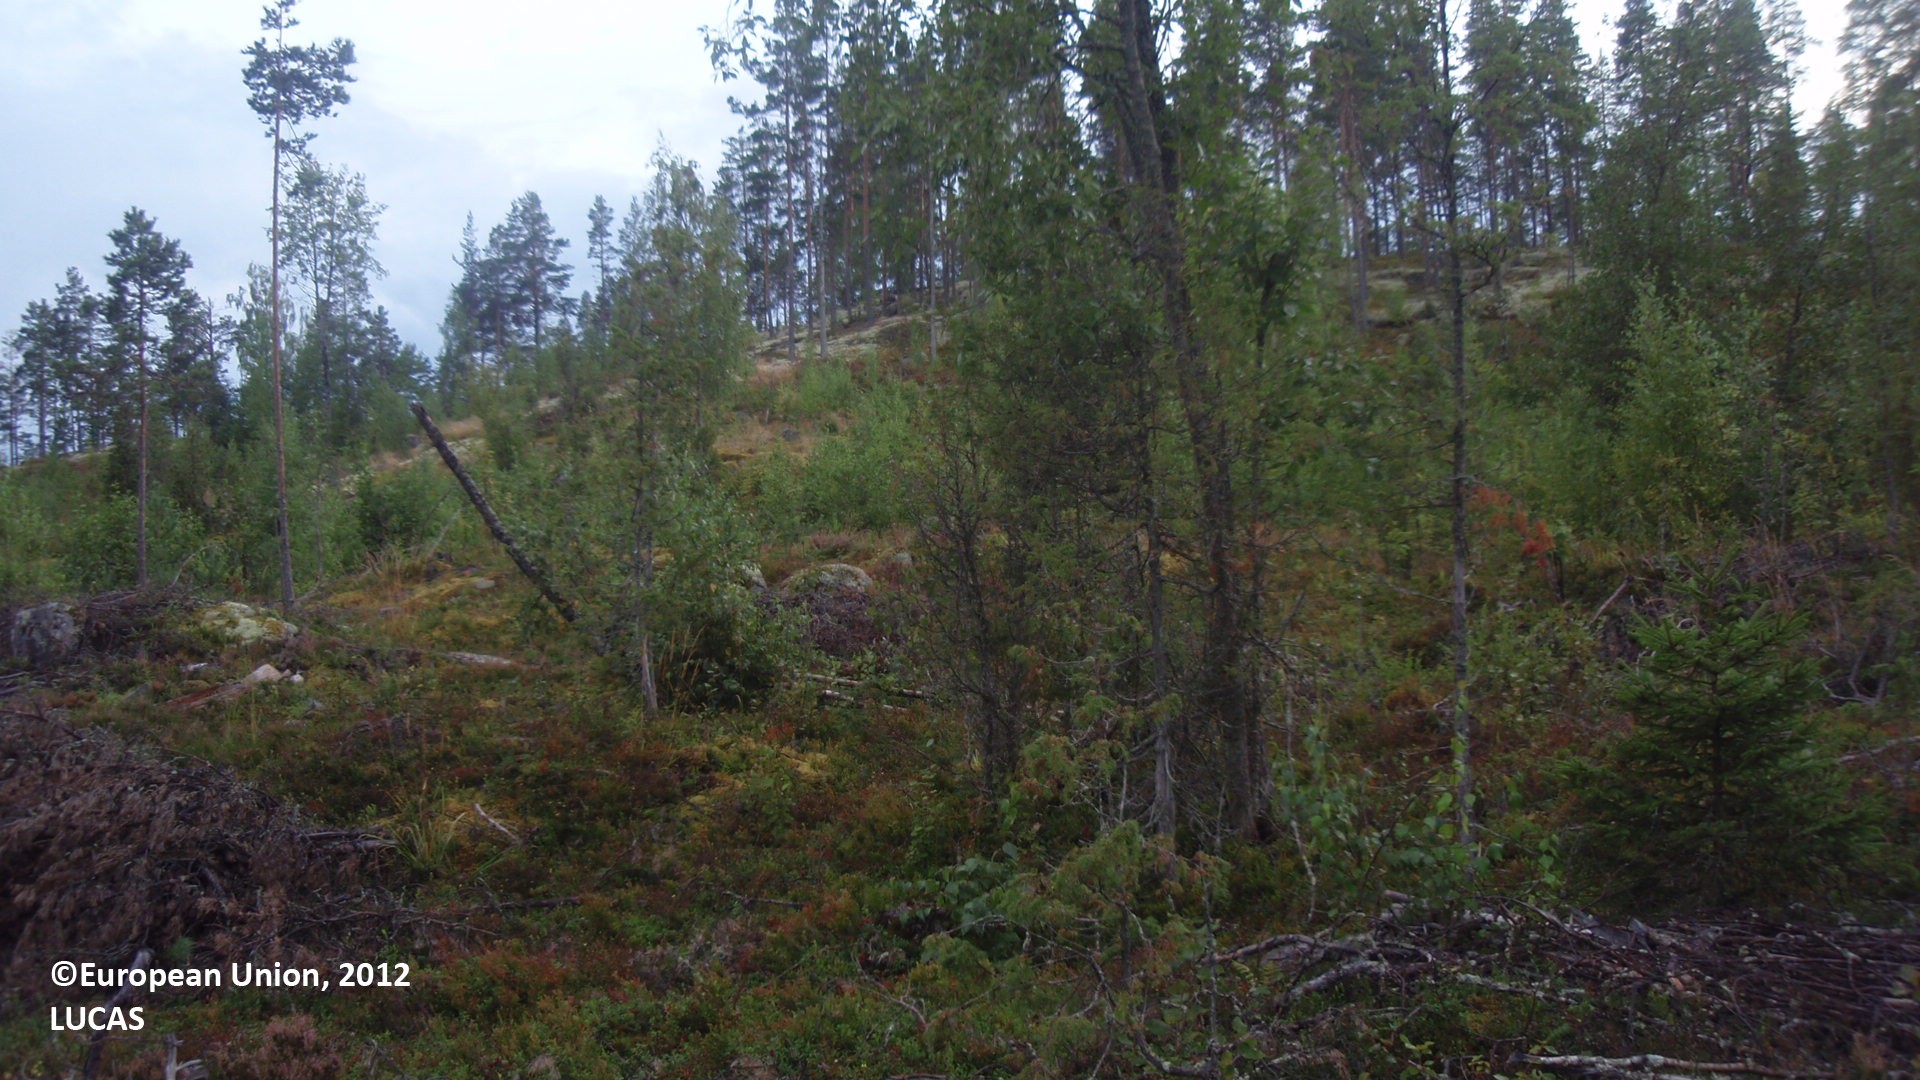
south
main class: Shrubland
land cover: Shrubland with sparse tree cover
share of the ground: > 75 %
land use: Forestry
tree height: > 5 m
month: August
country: FI
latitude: 61.5880
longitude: 27.8410
